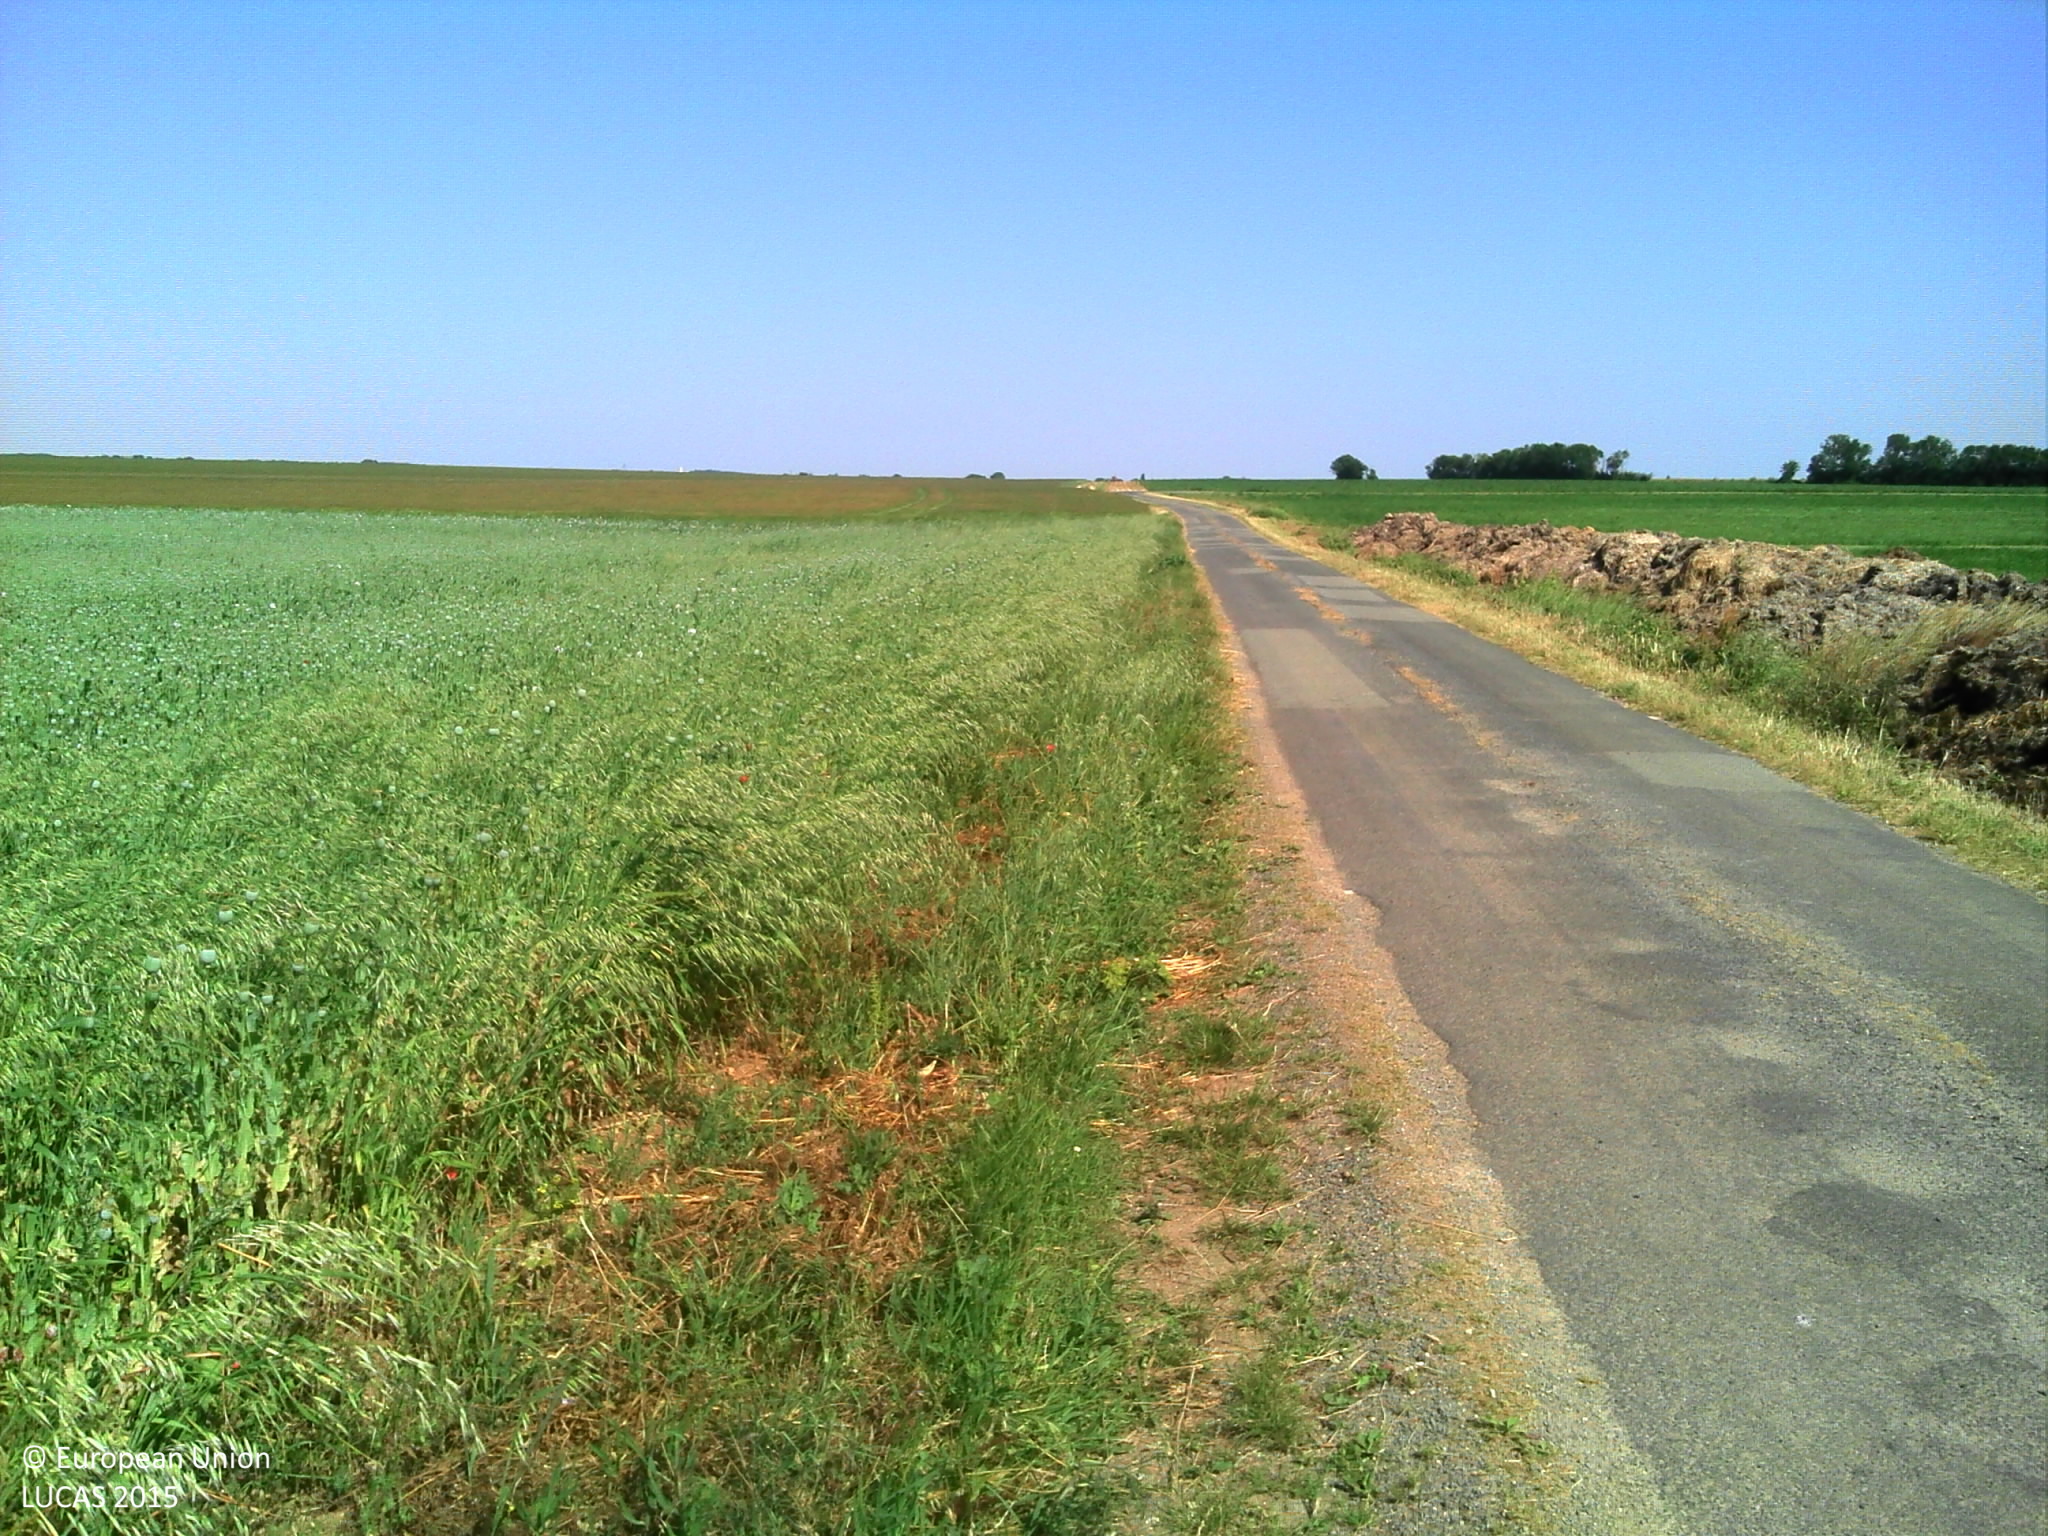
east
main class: Cropland
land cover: Mixed cereals for fodder
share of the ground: > 75 %
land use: Agriculture (excluding fallow land and kitchen gardens)
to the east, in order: Mixed cereals for fodder; Barley
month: June
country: FR
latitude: 46.0872
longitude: -1.0360
